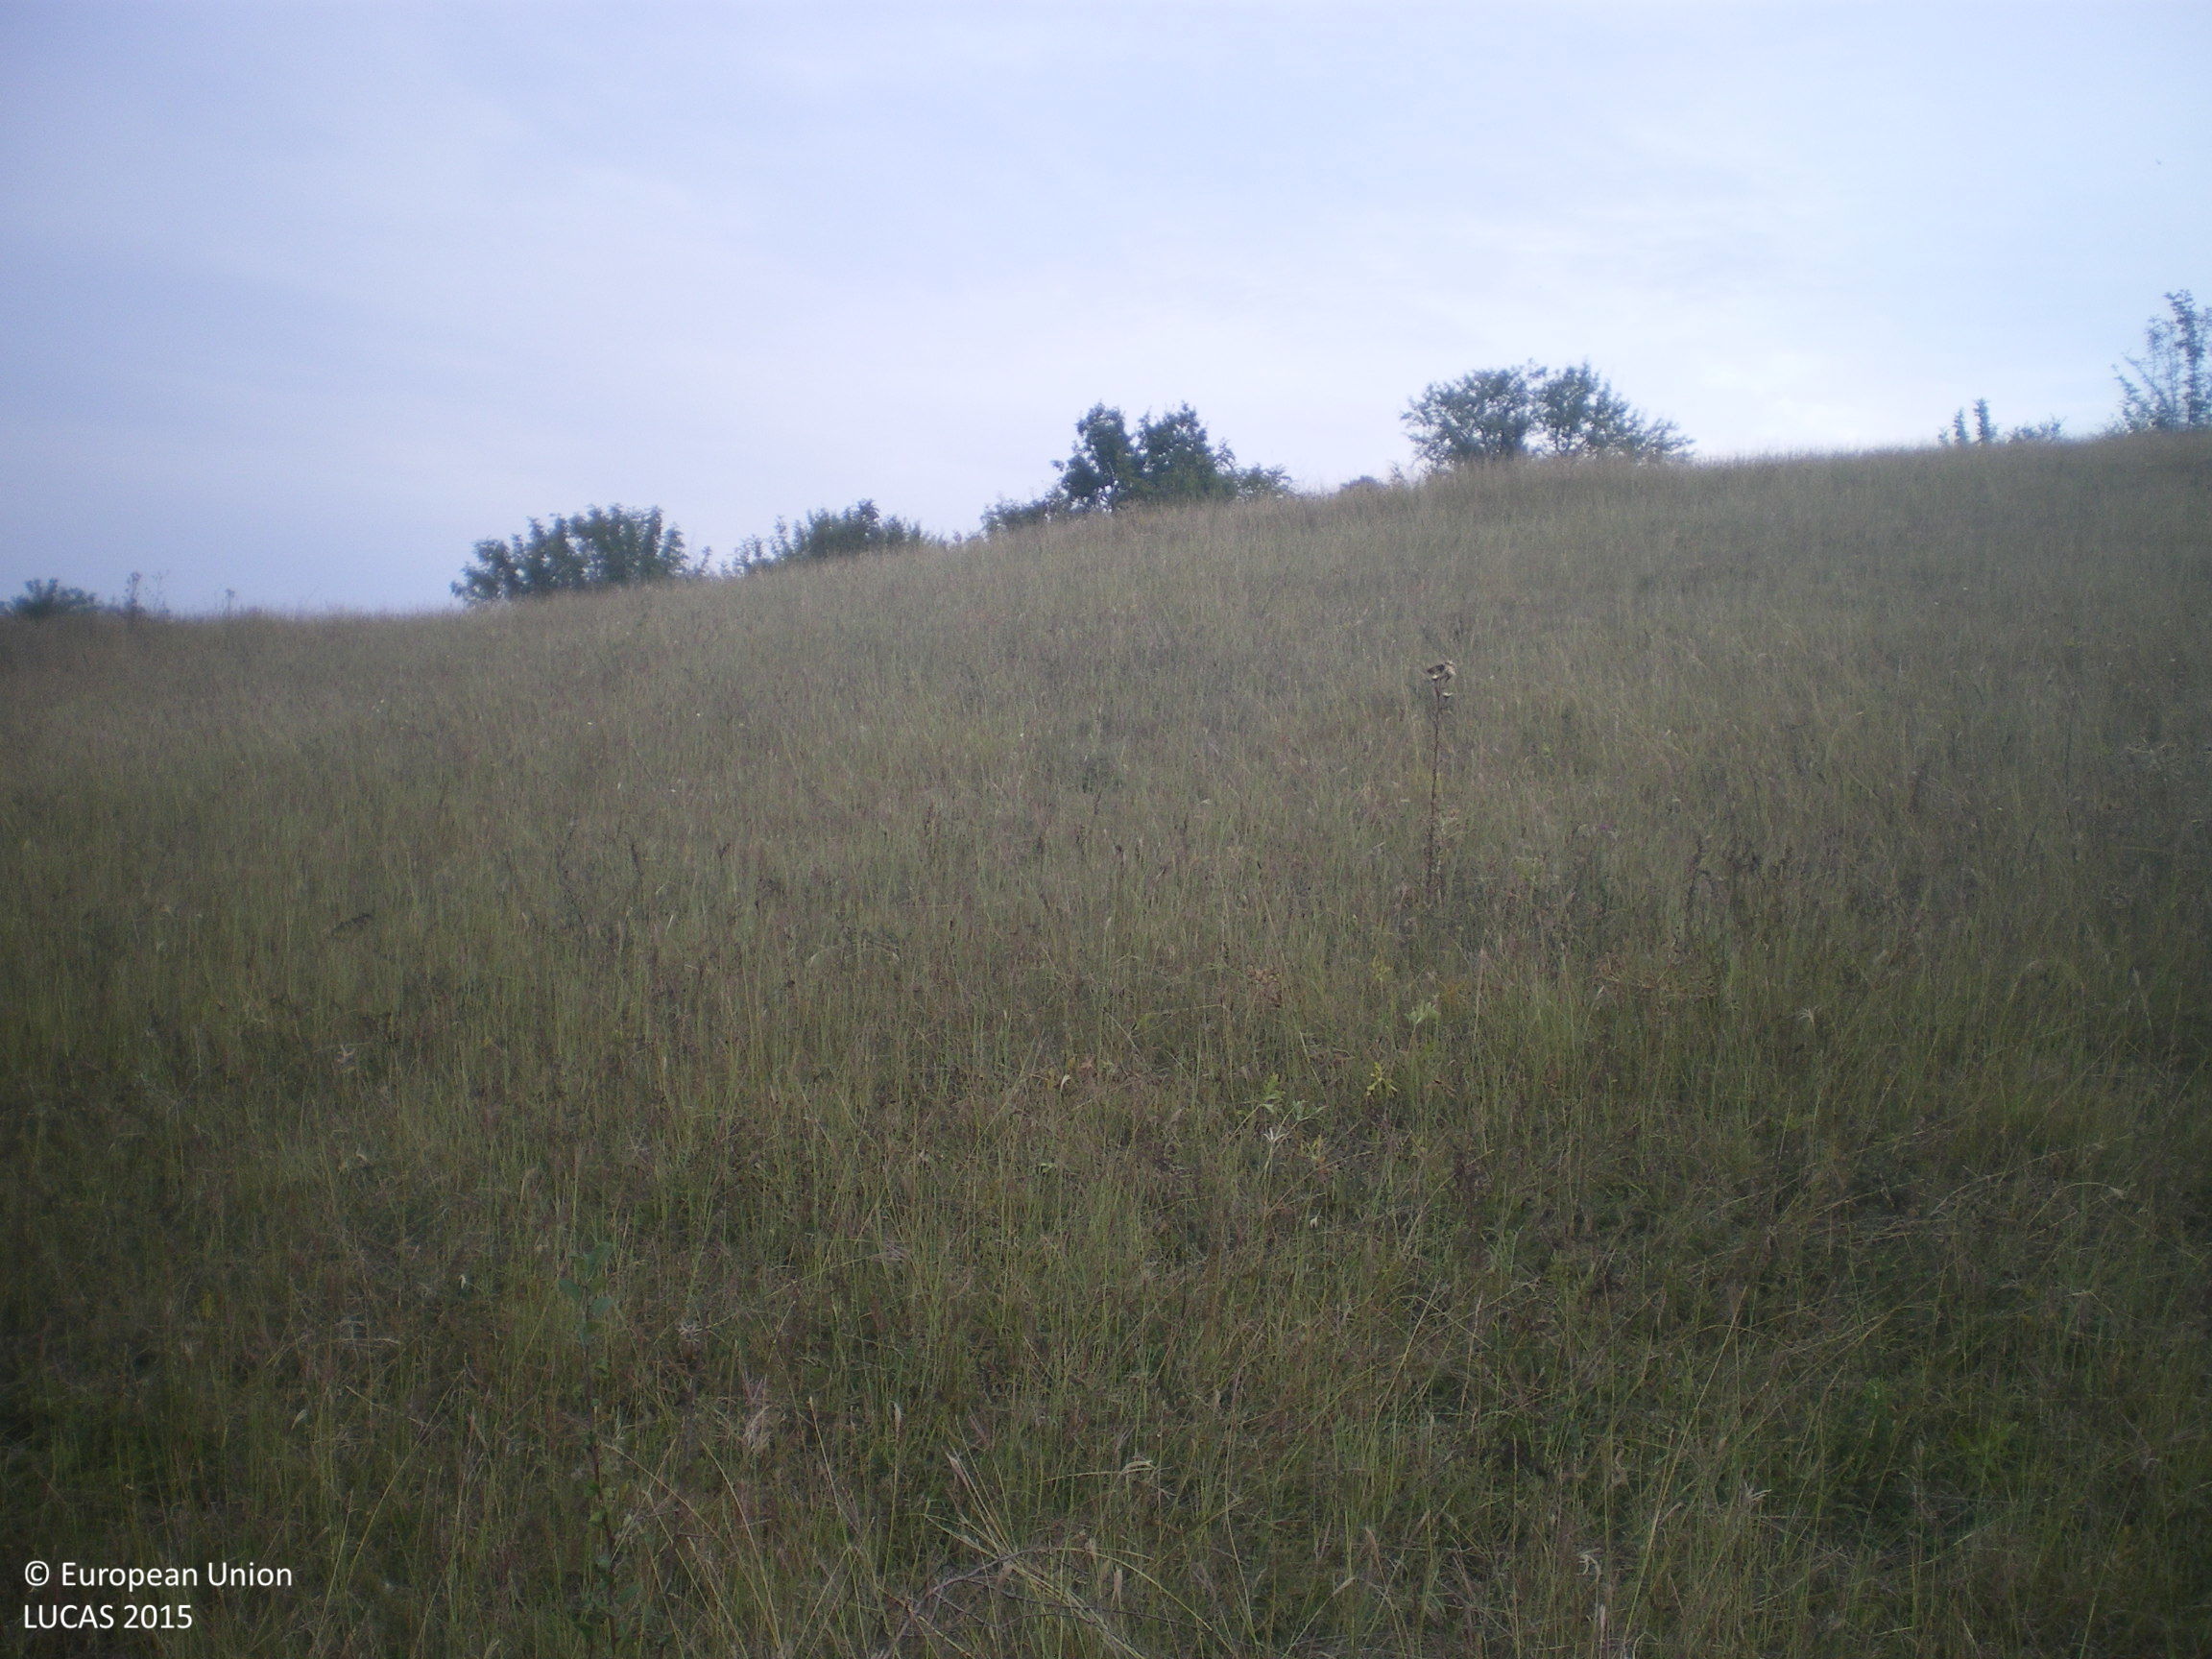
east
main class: Grassland
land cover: Grassland with sparse tree/shrub cover
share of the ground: > 75 %
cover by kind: herbaceous plants 90 %, broadleaved forest trees 5 %, shrubs 5 %
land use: Agriculture (excluding fallow land and kitchen gardens)
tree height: > 5 m
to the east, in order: Grassland with sparse tree/shrub cover; Broadleaved woodland
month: September
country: BG
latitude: 42.1323
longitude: 25.9598
